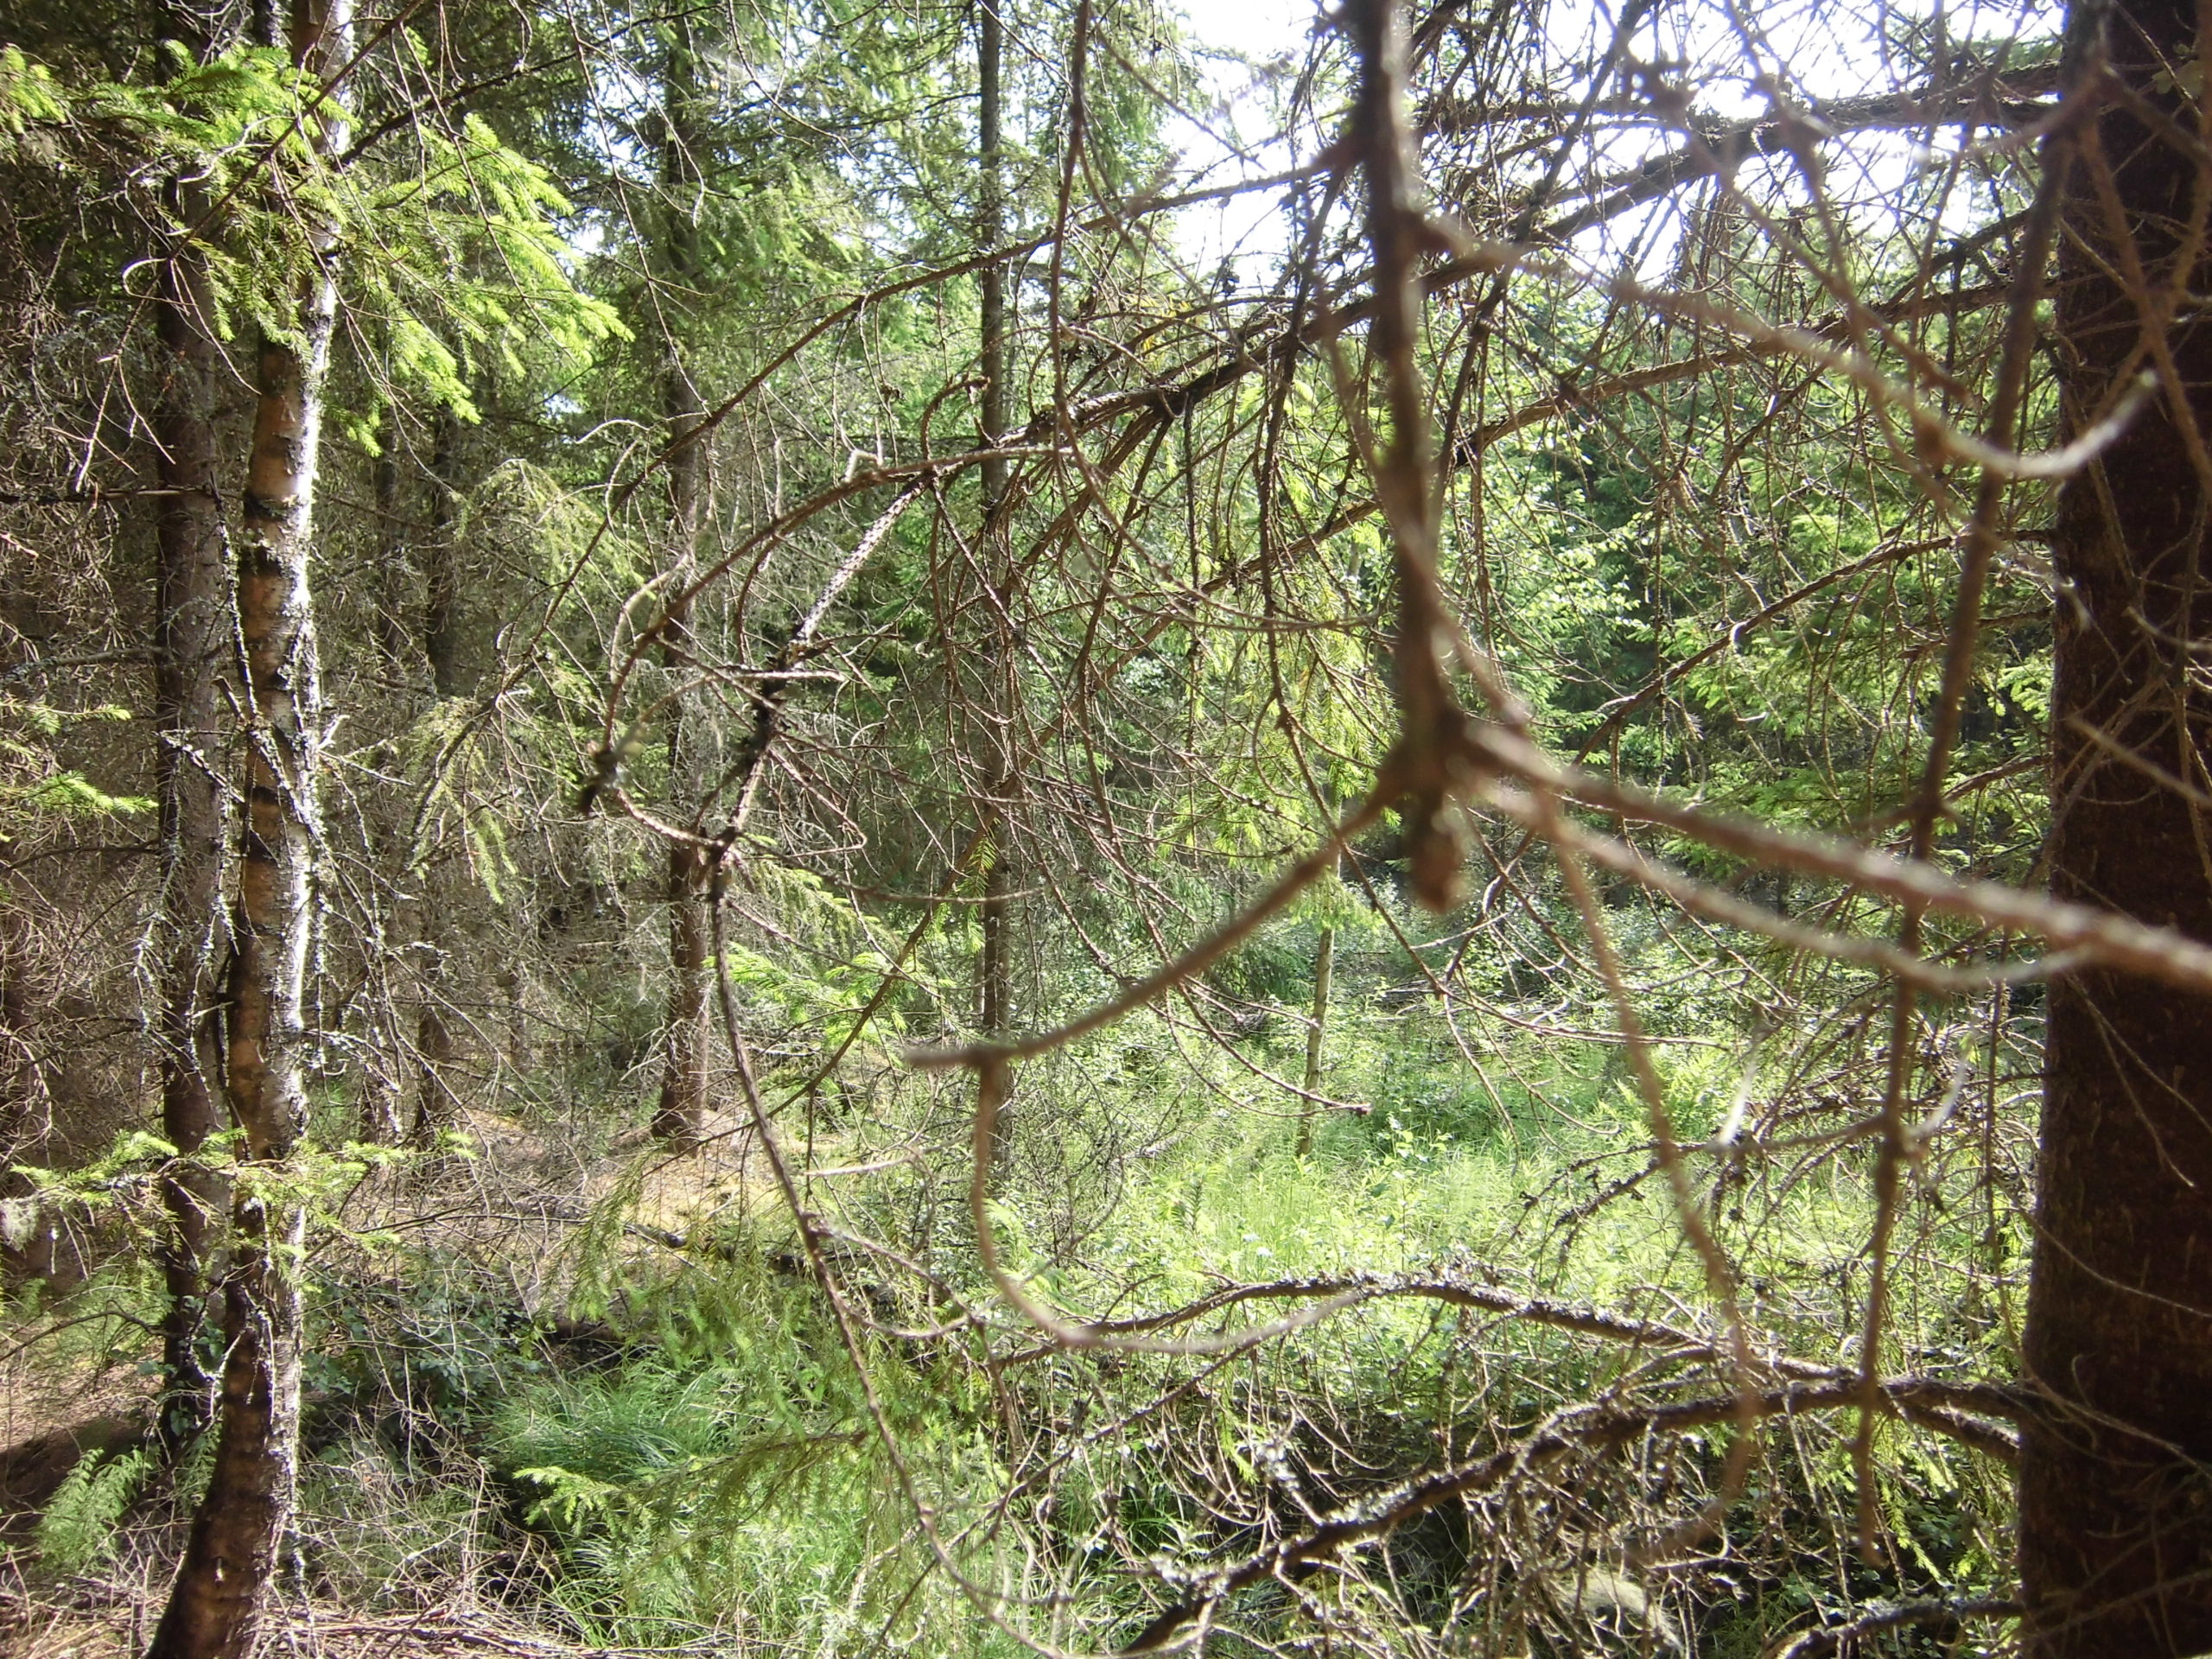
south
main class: Woodland
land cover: Spruce dominated coniferous woodland
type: boreal forest
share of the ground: > 75 %
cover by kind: coniferous forest trees 75 %, lichens and mosses 10 %, unconsolidated bare surface 10 %, broadleaved forest trees 5 %
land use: Forestry
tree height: > 5 m
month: July
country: SE
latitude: 57.3325
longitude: 14.5309
